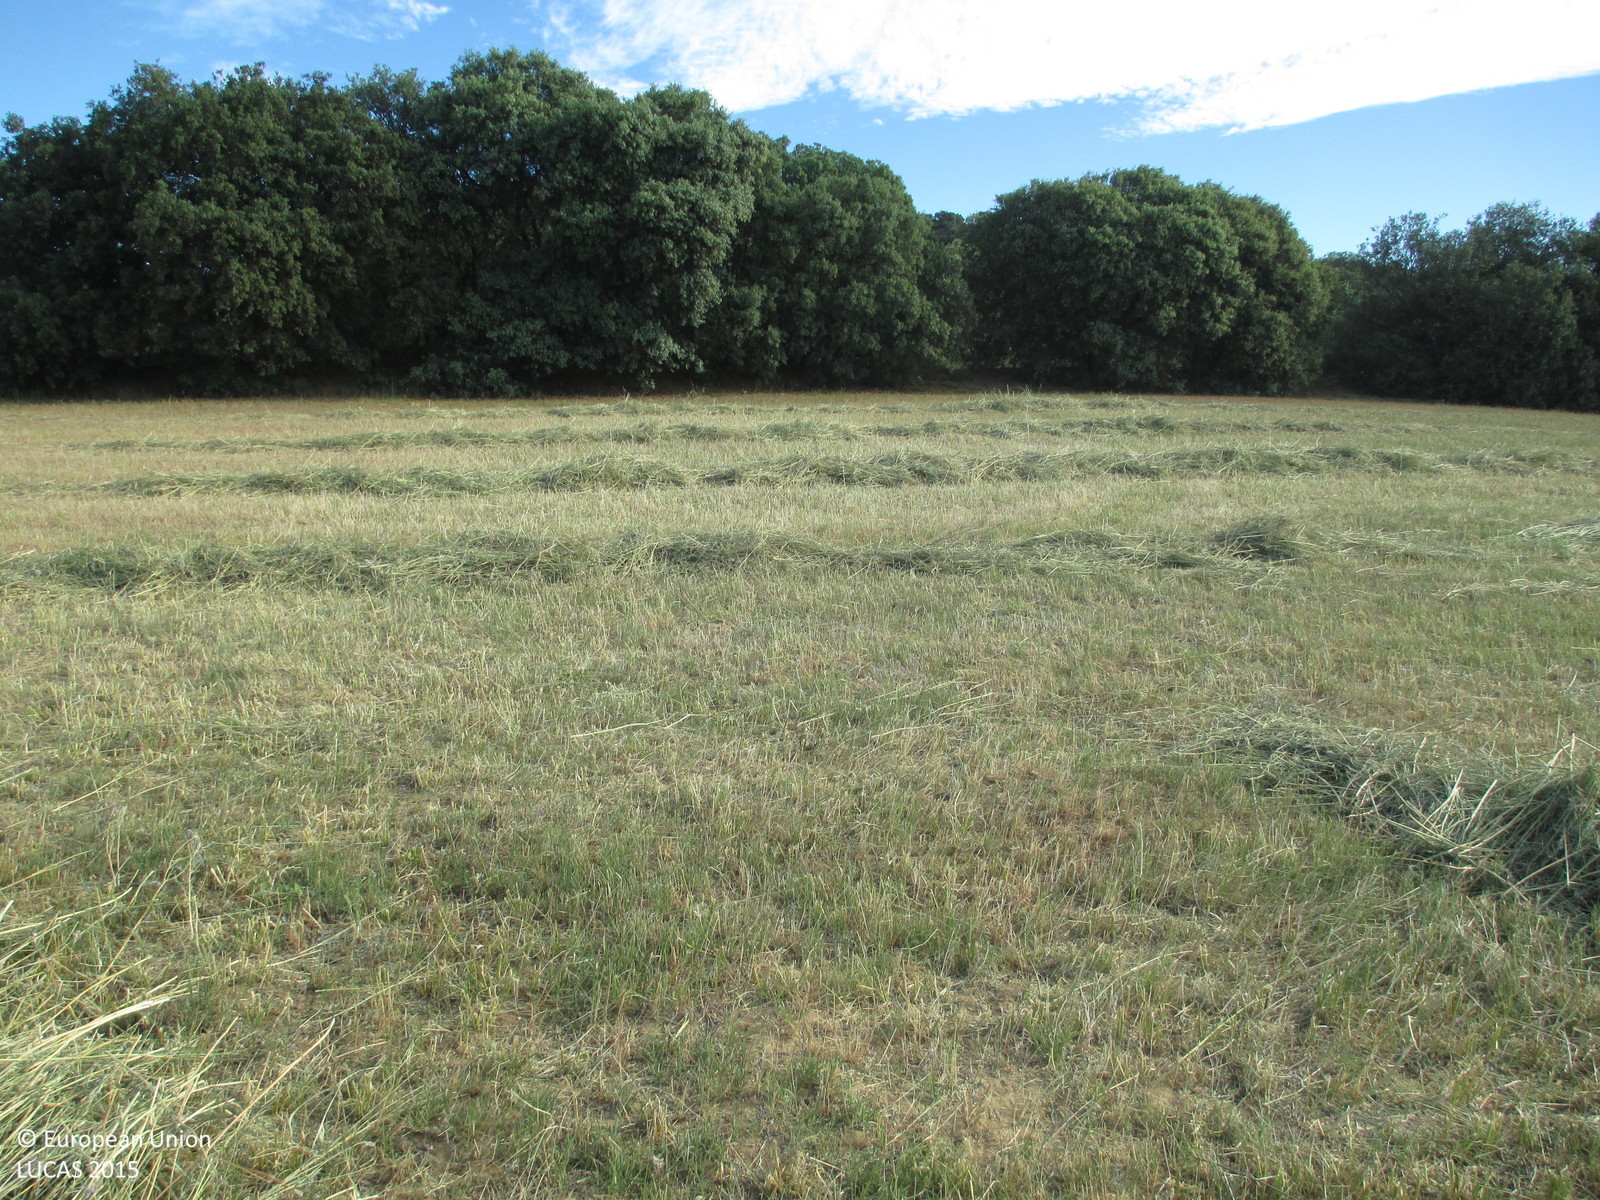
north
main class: Cropland
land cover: Lucerne
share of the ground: > 75 %
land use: Agriculture (excluding fallow land and kitchen gardens)
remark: Harvested field
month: May
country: ES
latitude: 42.0951
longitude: -0.2621
